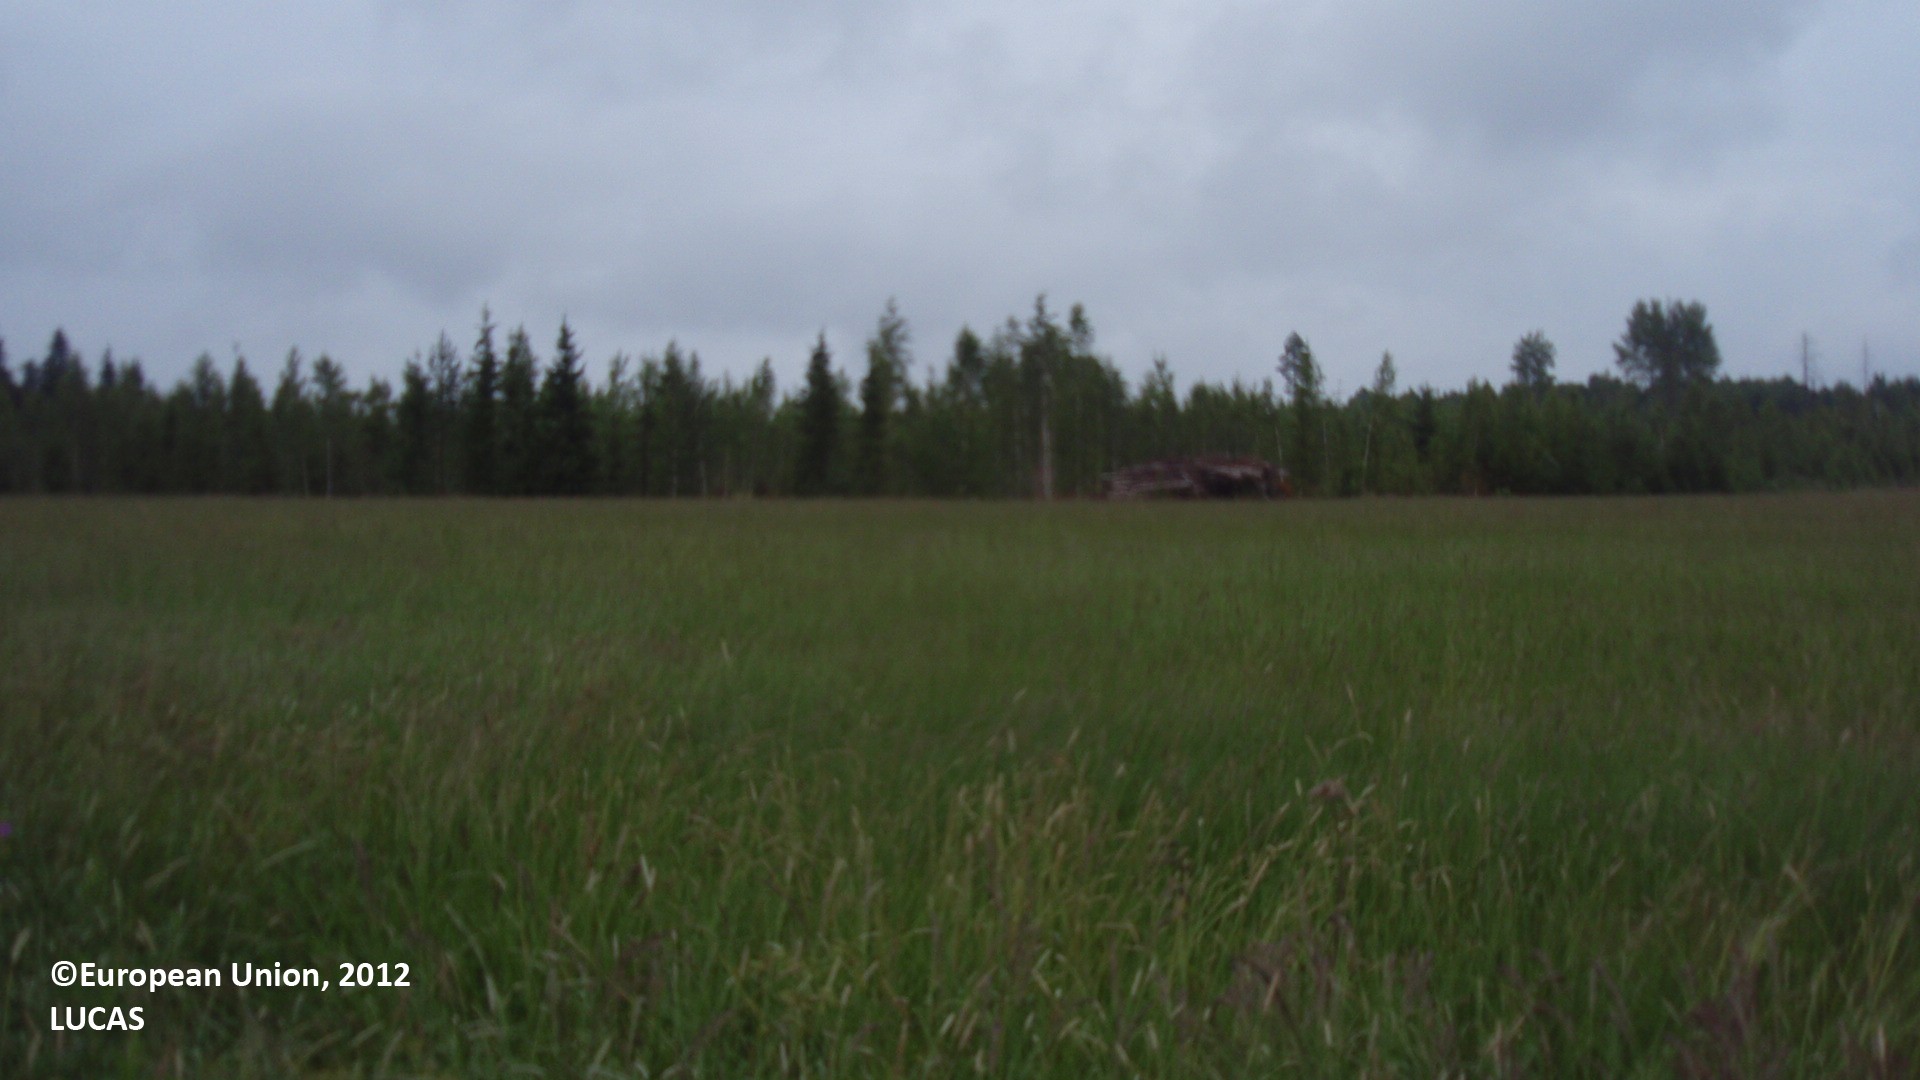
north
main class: Cropland
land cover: Oats
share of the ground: > 75 %
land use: Agriculture (excluding fallow land and kitchen gardens)
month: July
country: FI
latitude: 61.0987
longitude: 28.7551
